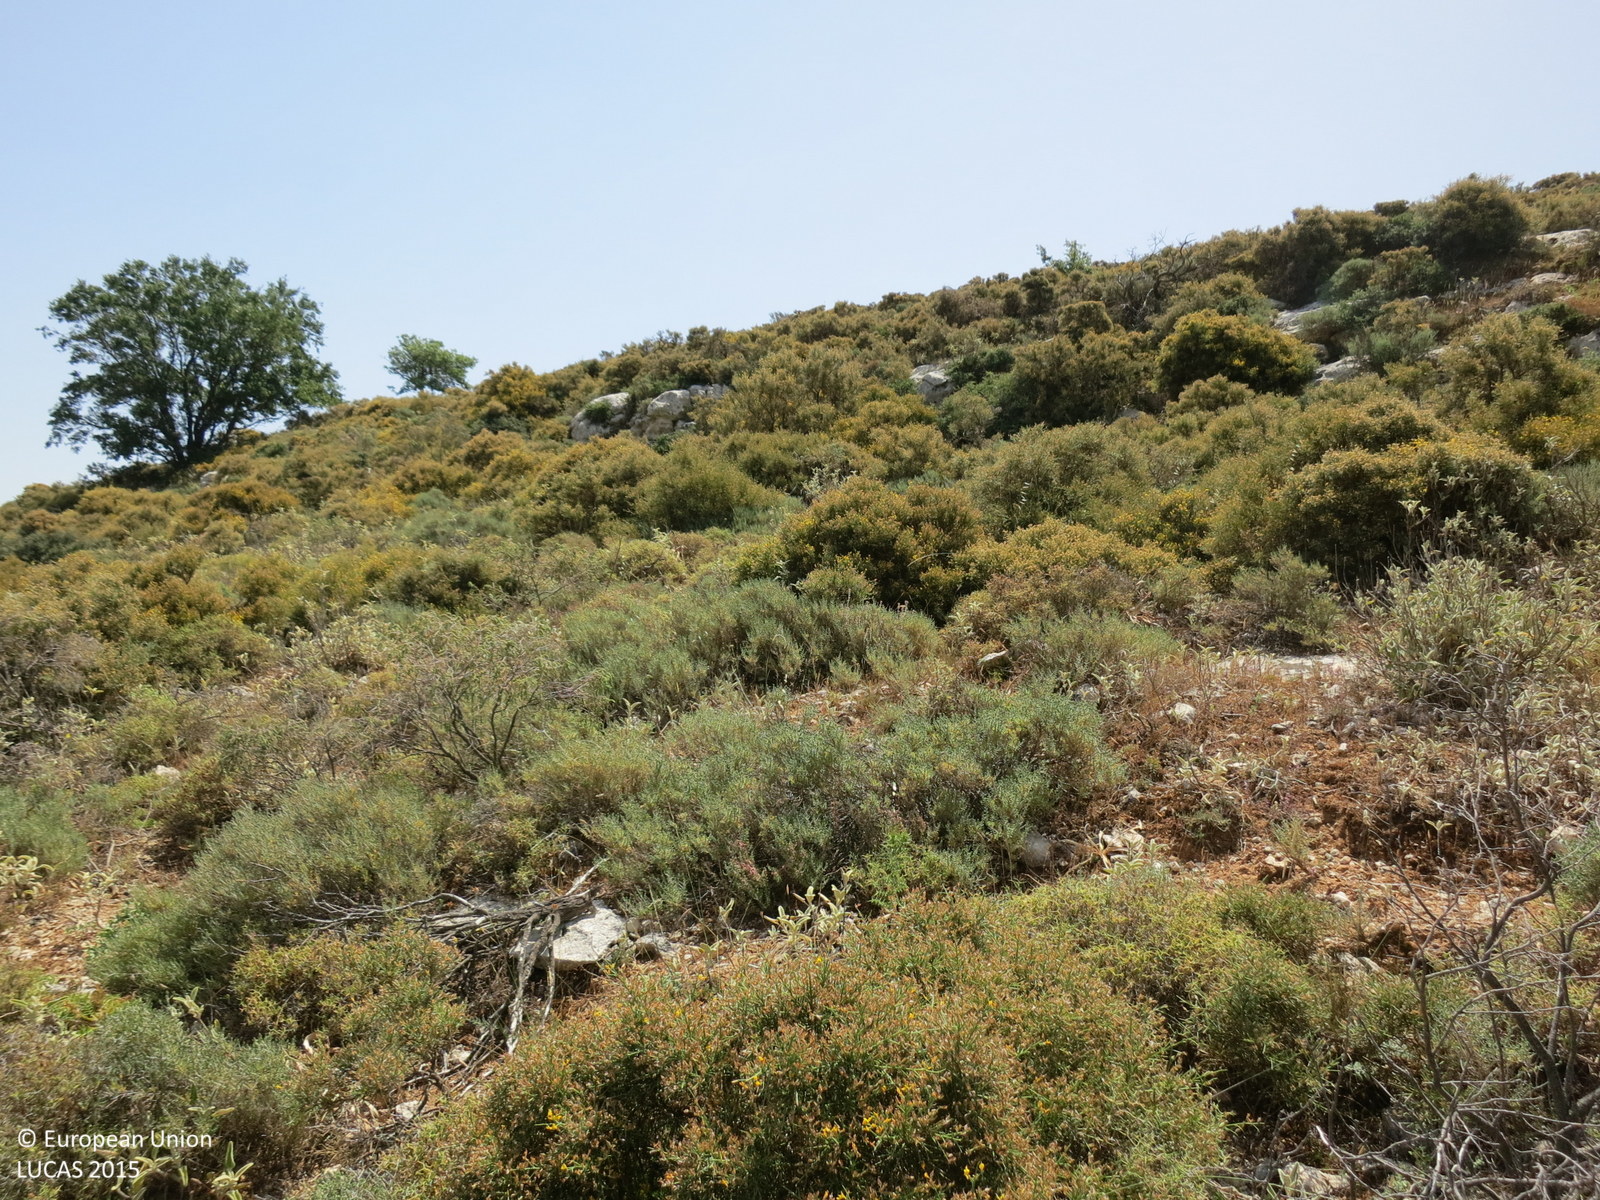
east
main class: Shrubland
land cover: Shrubland without tree cover
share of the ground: > 75 %
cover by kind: shrubs 95 %, consolidated bare surface 5 %
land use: Semi-natural and natural areas not in use
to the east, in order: Shrubland without tree cover; Rock outcrops; Shrubland without tree cover; Shrubland with sparse tree cover; Rock outcrops; Shrubland with sparse tree cover; Fences; Olive groves; Shrubland with sparse tree cover; Dry stone walls
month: June
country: GR
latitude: 35.1690
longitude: 24.9973
